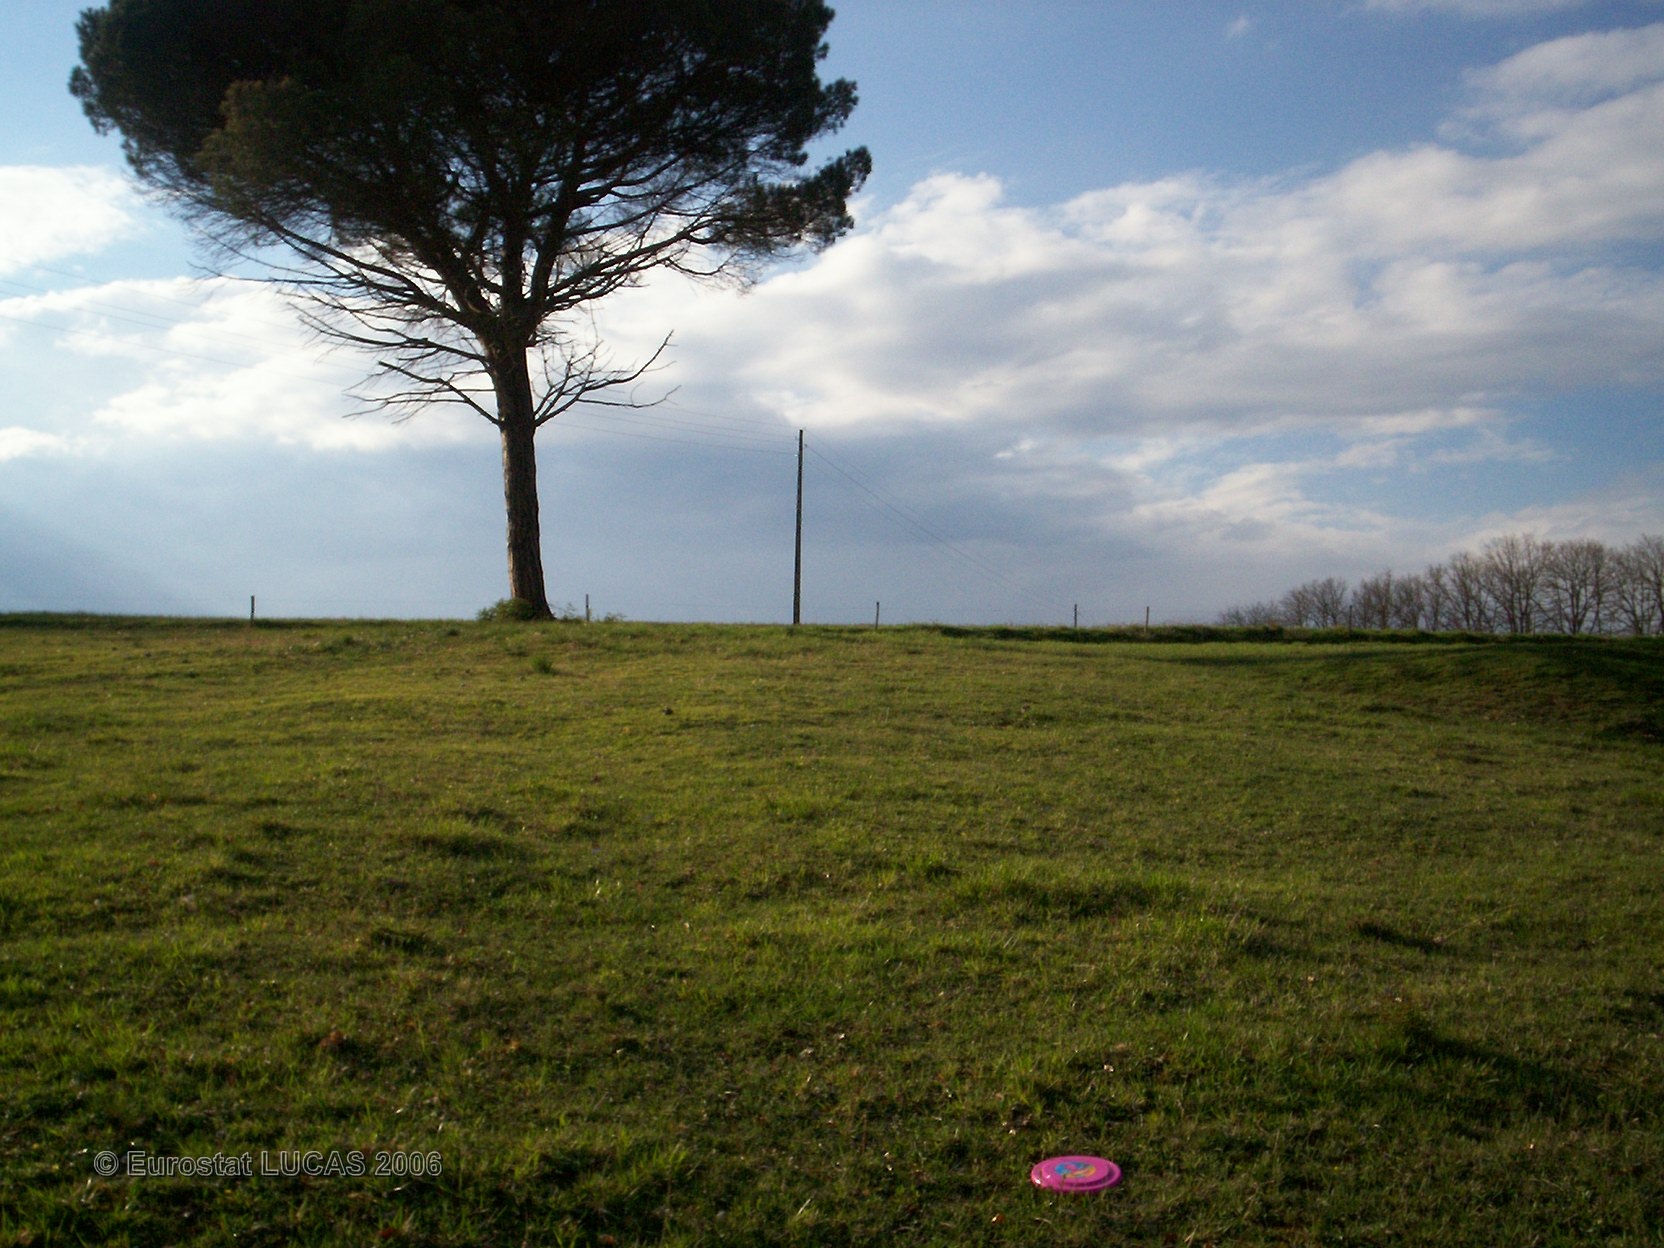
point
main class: Grassland
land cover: Grassland without tree/shrub cover
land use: Agriculture (excluding fallow land and kitchen gardens)
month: April
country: FR
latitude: 43.9616
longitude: 0.2350
